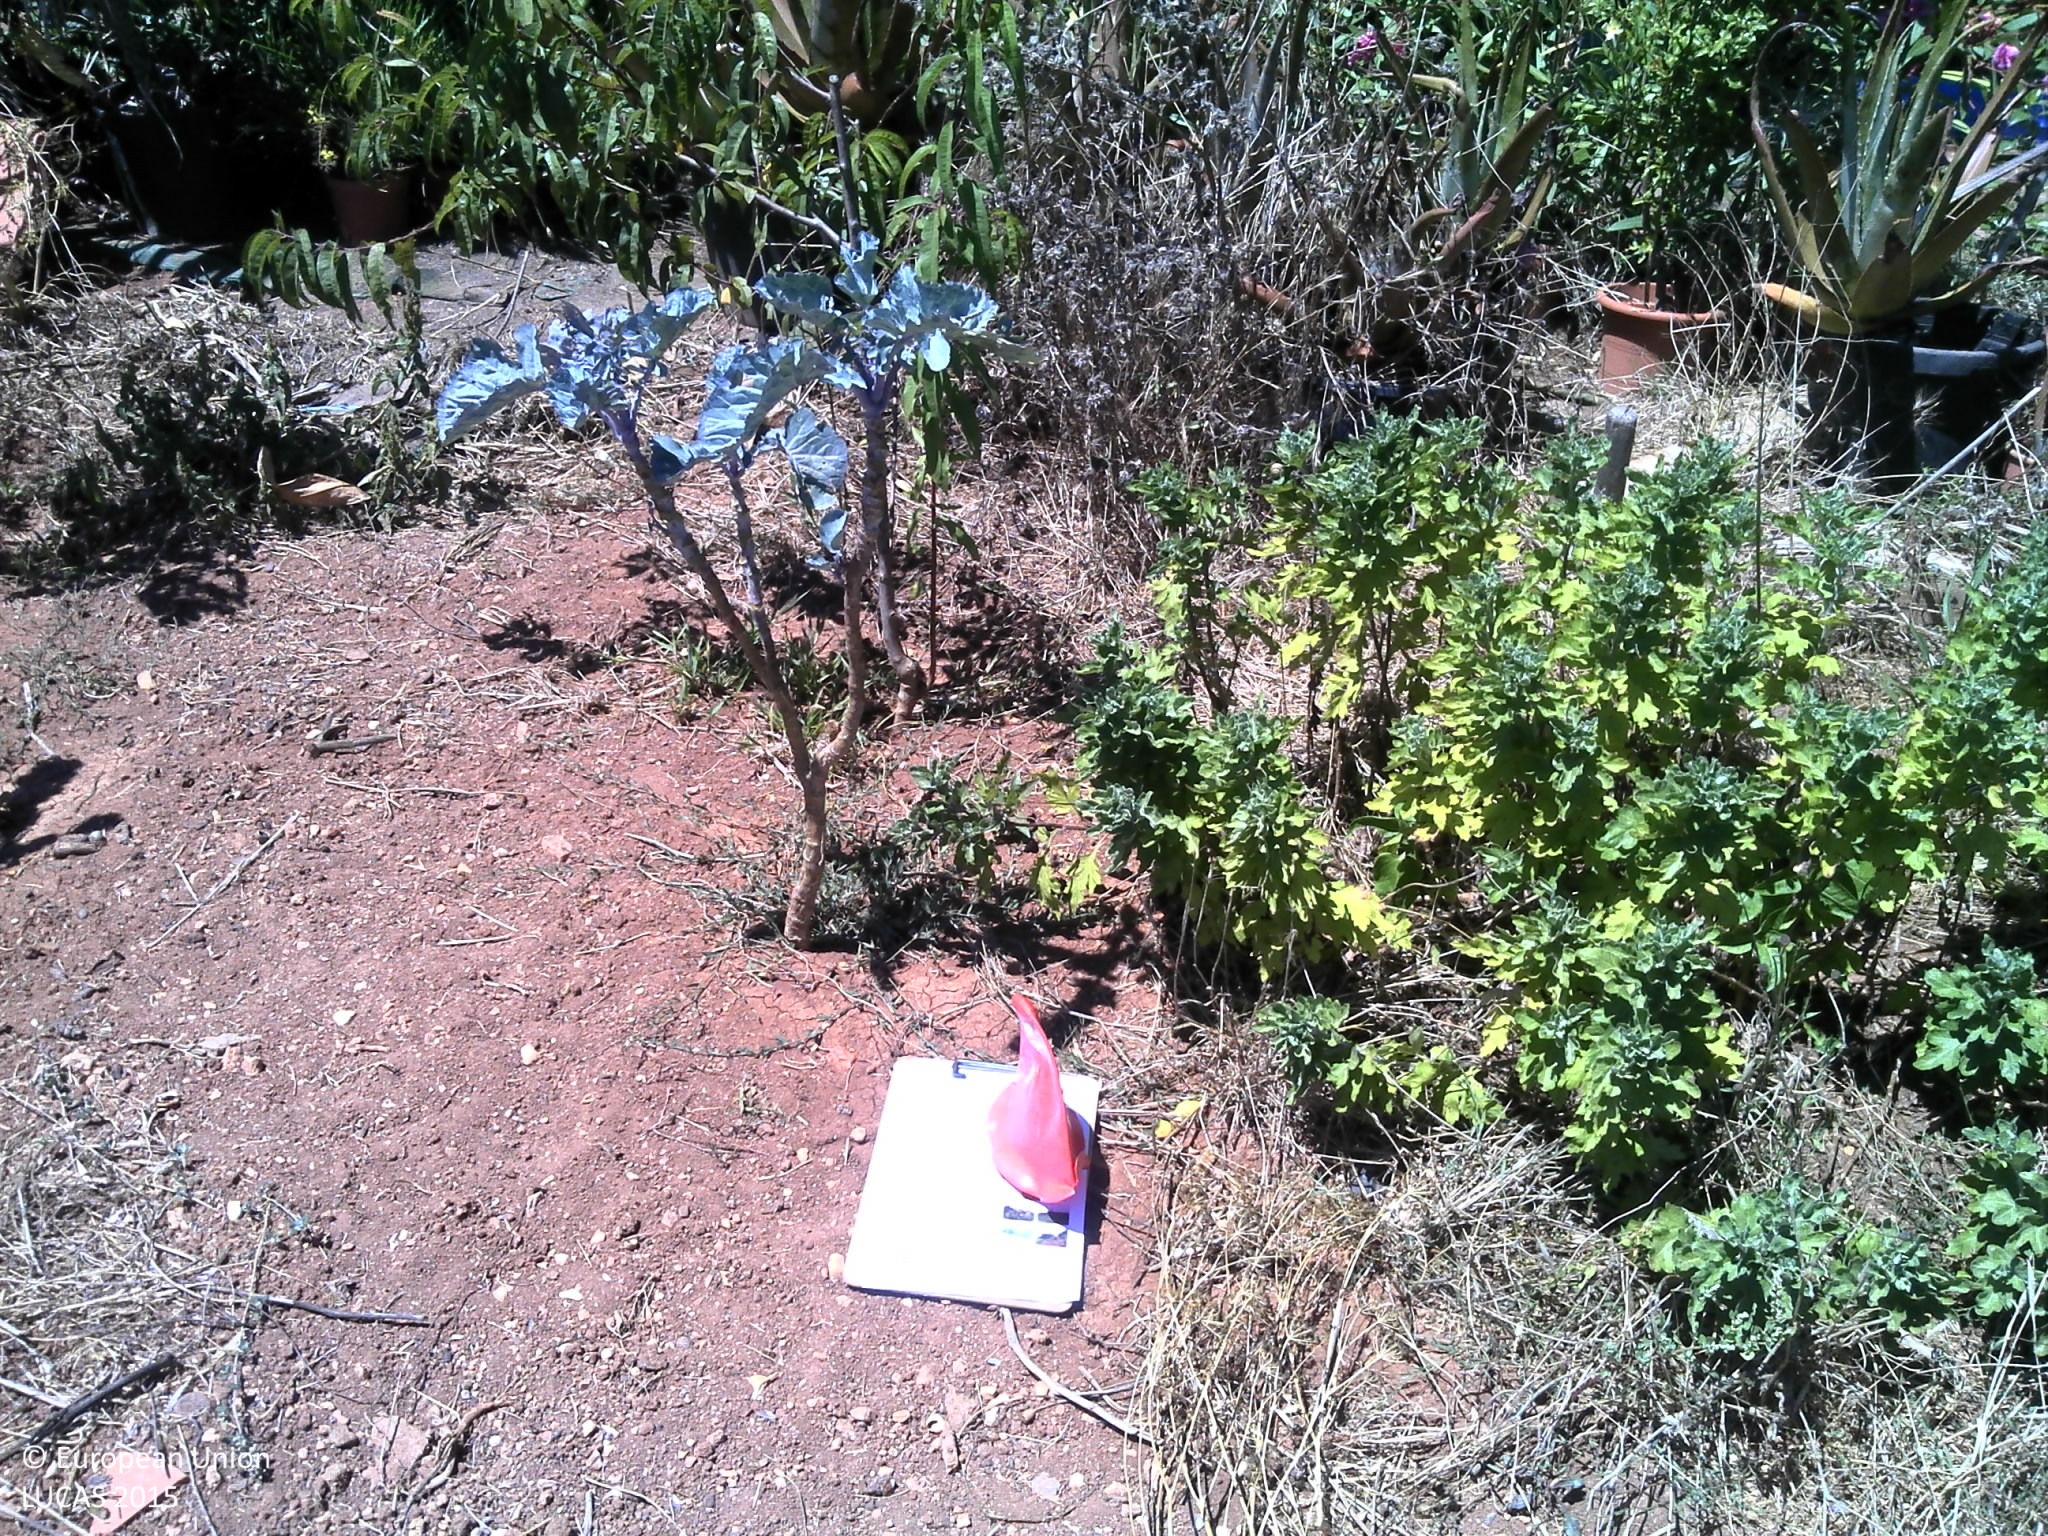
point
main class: Cropland
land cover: Other fresh vegetables
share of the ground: < 10 %
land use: Kitchen garden
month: July
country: PT
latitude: 37.0729
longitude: -8.9186
